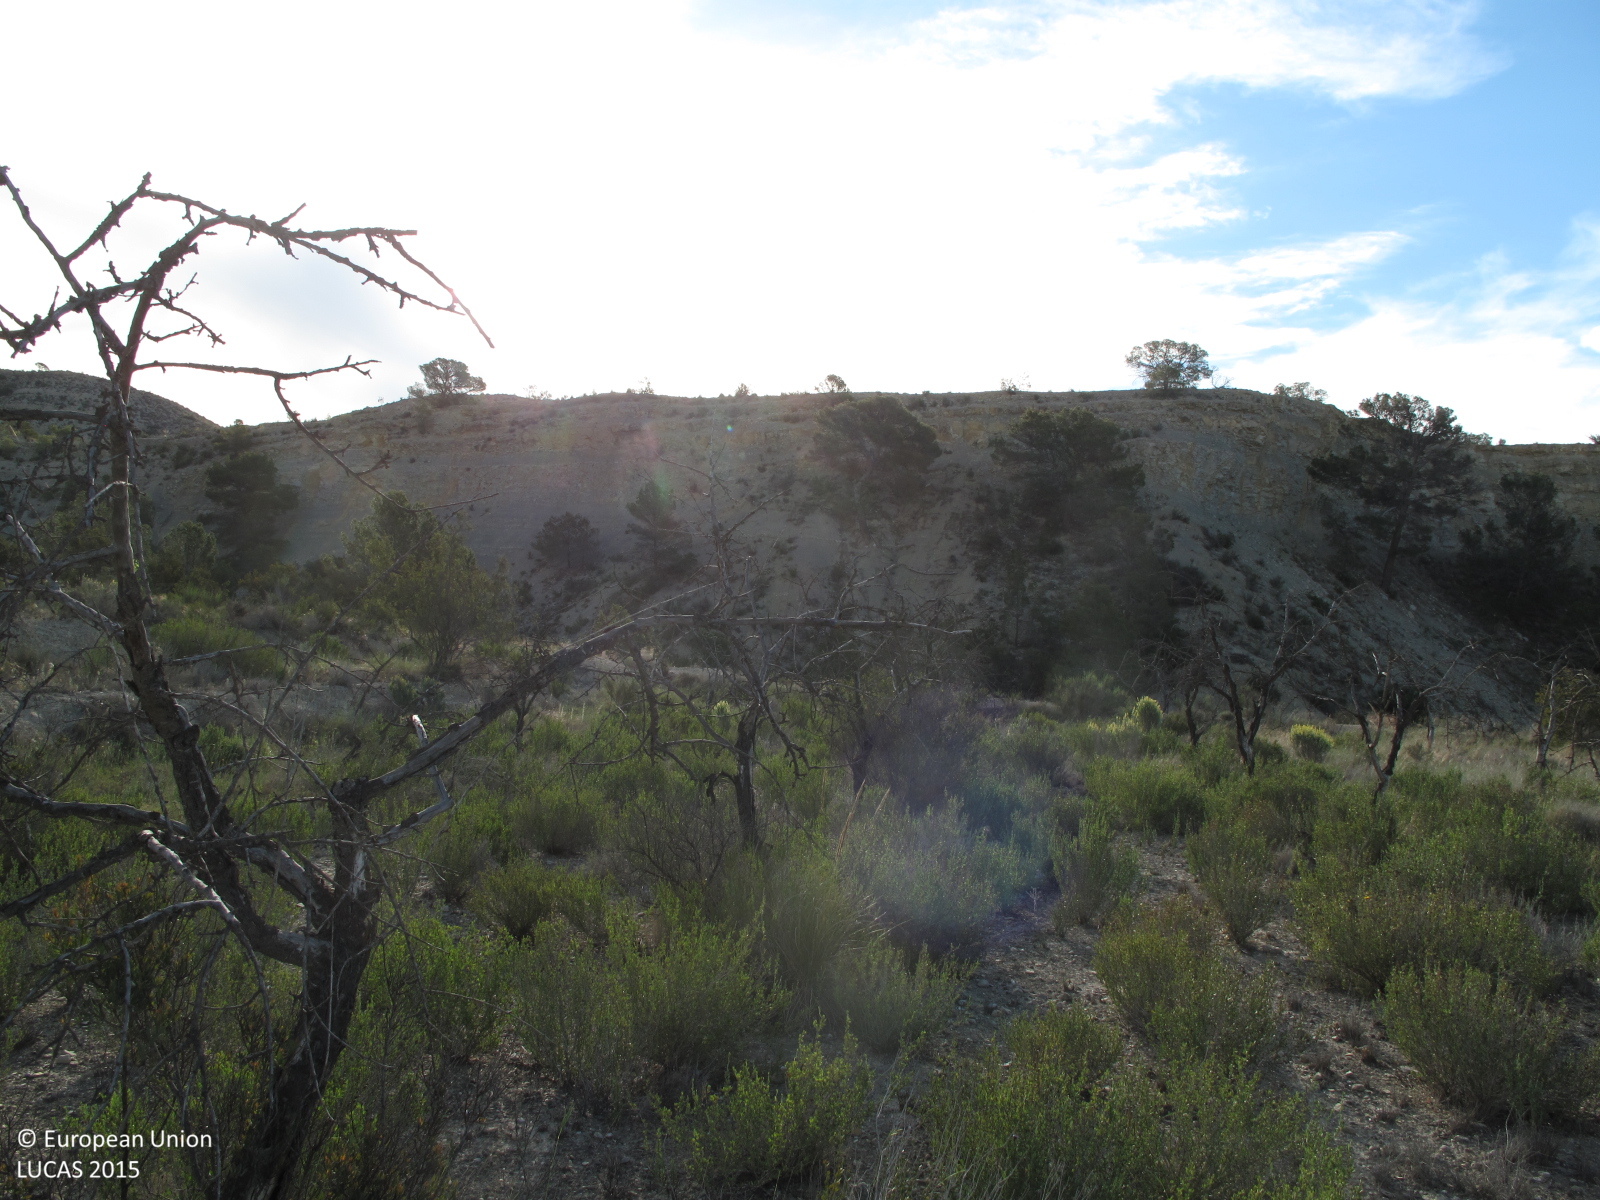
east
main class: Shrubland
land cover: Shrubland with sparse tree cover
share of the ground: 50 - 75 %
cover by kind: shrubs 50 %, consolidated bare surface 35 %, herbaceous plants 10 %, coniferous forest trees 5 %
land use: Abandoned areas
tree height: < 5 m
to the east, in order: Shrubland with sparse tree cover; Pine dominated coniferous woodland; Other bare soil; Shrubland with sparse tree cover; Tracks; Other bare soil; Shruby margins; Tracks; Shruby margins; Olive groves; Shrubland without tree cover; Olive groves
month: April
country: ES
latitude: 38.5209
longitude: -0.4591
